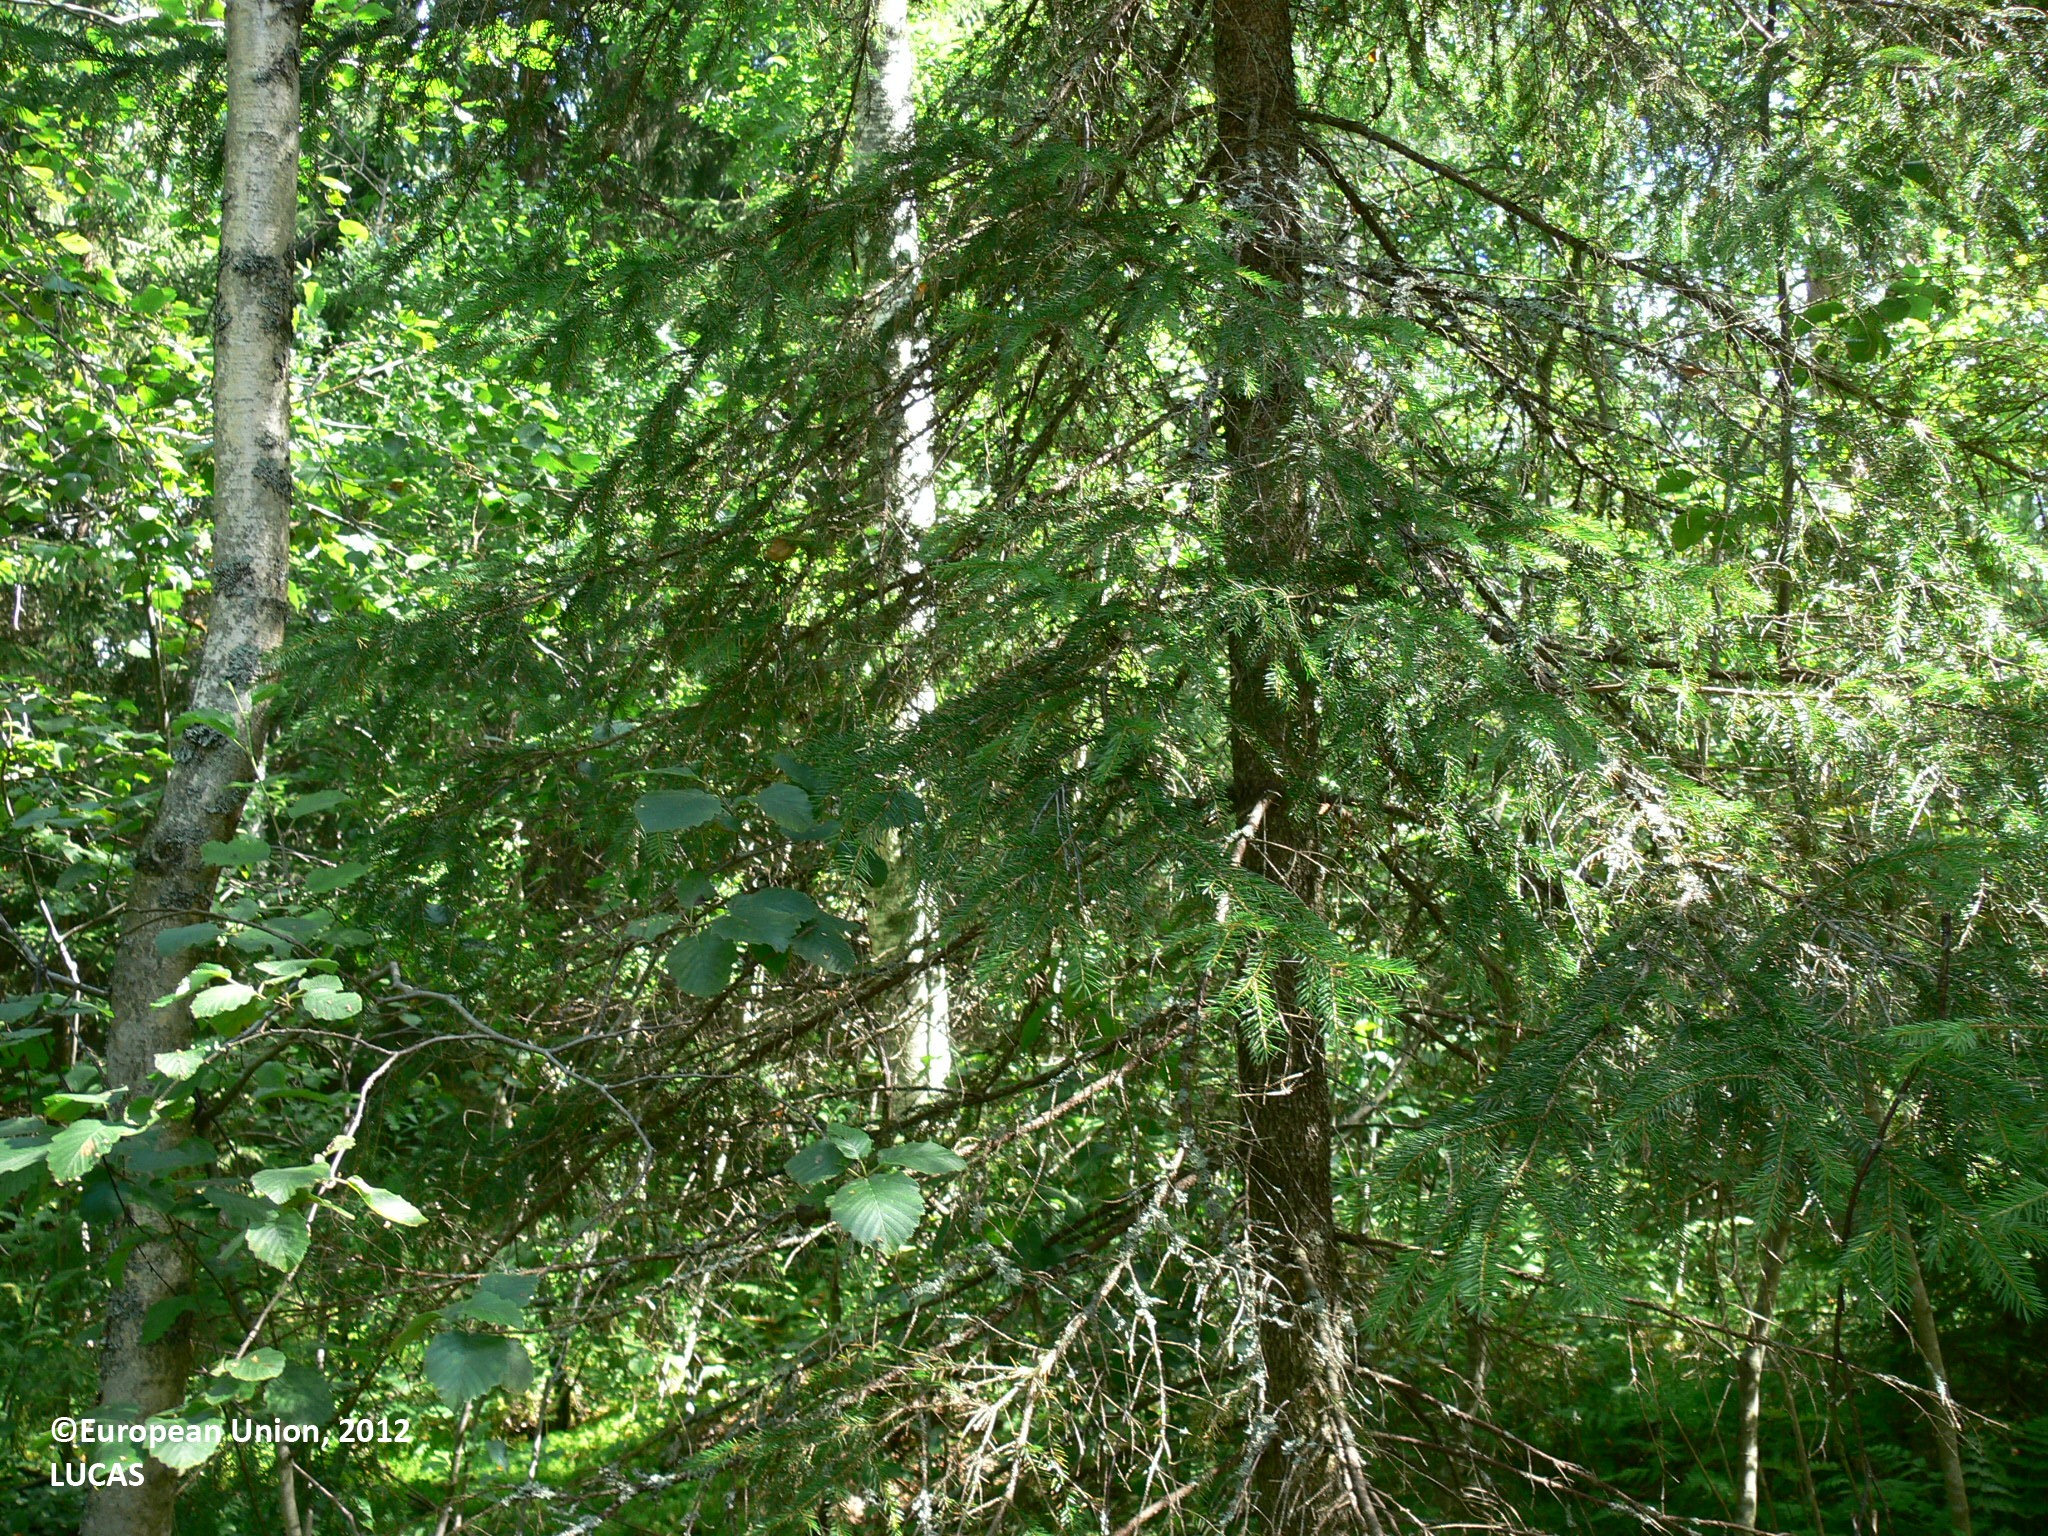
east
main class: Woodland
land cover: Other mixed woodland
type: boreal forest
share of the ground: > 75 %
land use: Forestry
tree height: > 5 m
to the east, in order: Other mixed woodland; Grassland without tree/shrub cover; Electric lines; Grassland without tree/shrub cover; Paved roads, cycling and walking lanes; Grassland without tree/shrub cover; Other mixed woodland; Broadleaved woodland; Spruce dominated coniferous woodland
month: August
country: FI
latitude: 62.1325
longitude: 30.3590
